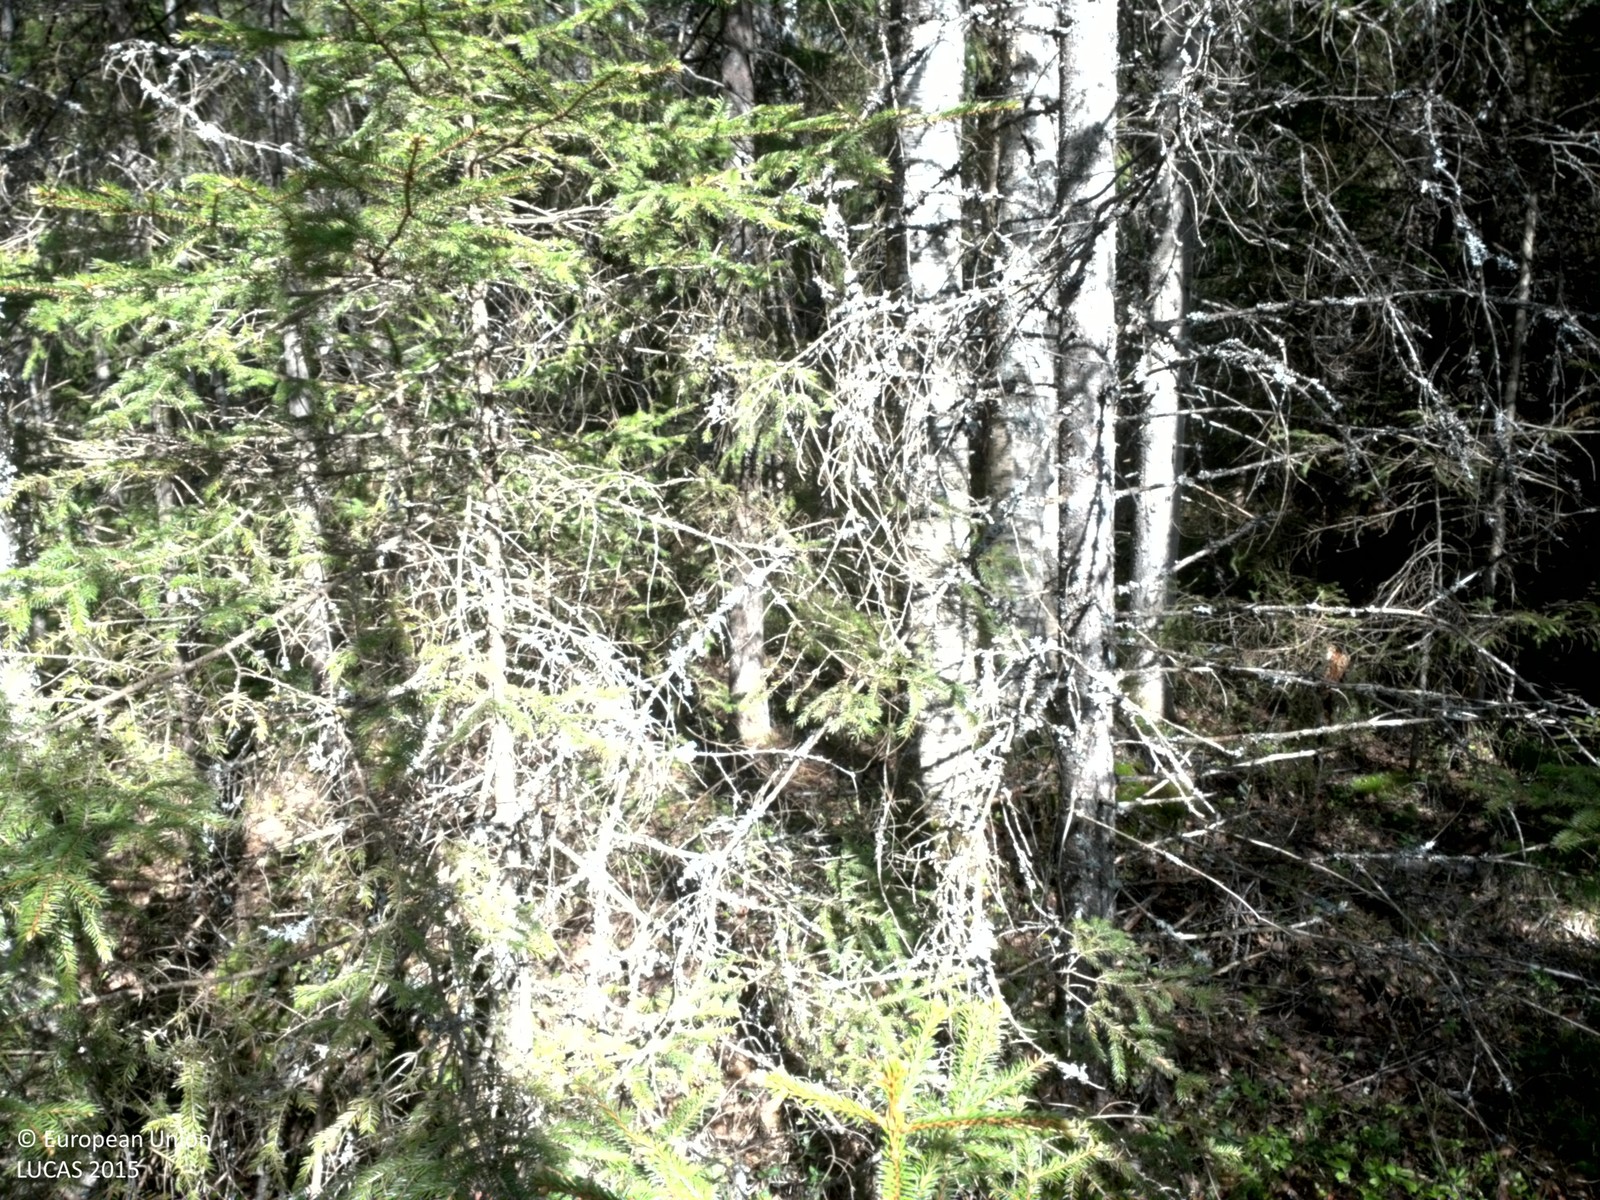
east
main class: Woodland
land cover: Spruce dominated mixed woodland
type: boreal forest
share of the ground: > 75 %
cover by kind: coniferous forest trees 75 %, broadleaved forest trees 25 %
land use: Forestry
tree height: > 5 m
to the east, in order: Spruce dominated mixed woodland; Electric lines; Spruce dominated mixed woodland; Fences; Dry stone walls; Other bare soil; Grass margins; Dry stone walls; Fences; Grassland with sparse tree/shrub cover; Fences; Tracks; Grassland with sparse tree/shrub cover
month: May
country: SE
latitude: 56.5421
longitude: 15.4145
